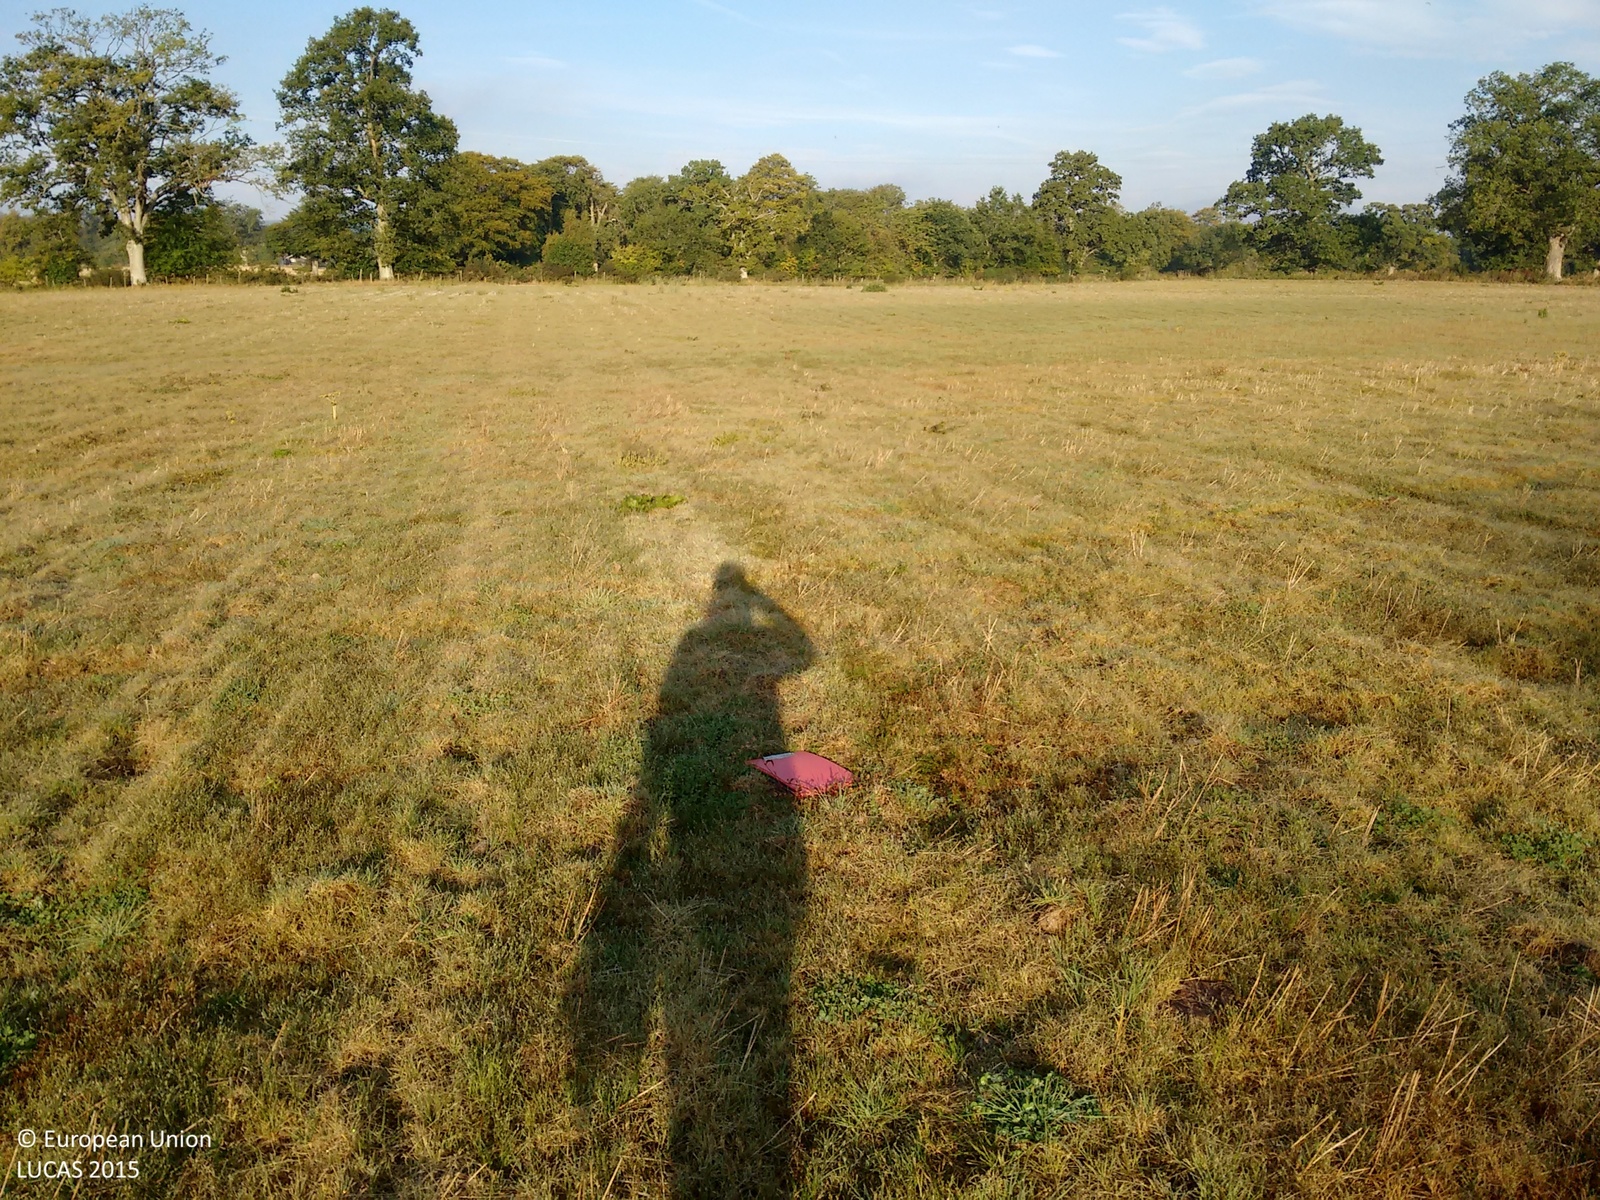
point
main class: Grassland
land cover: Grassland without tree/shrub cover
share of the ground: > 75 %
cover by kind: herbaceous plants 100 %
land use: Agriculture (excluding fallow land and kitchen gardens)
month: September
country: GB
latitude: 56.3312
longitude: -3.8133
